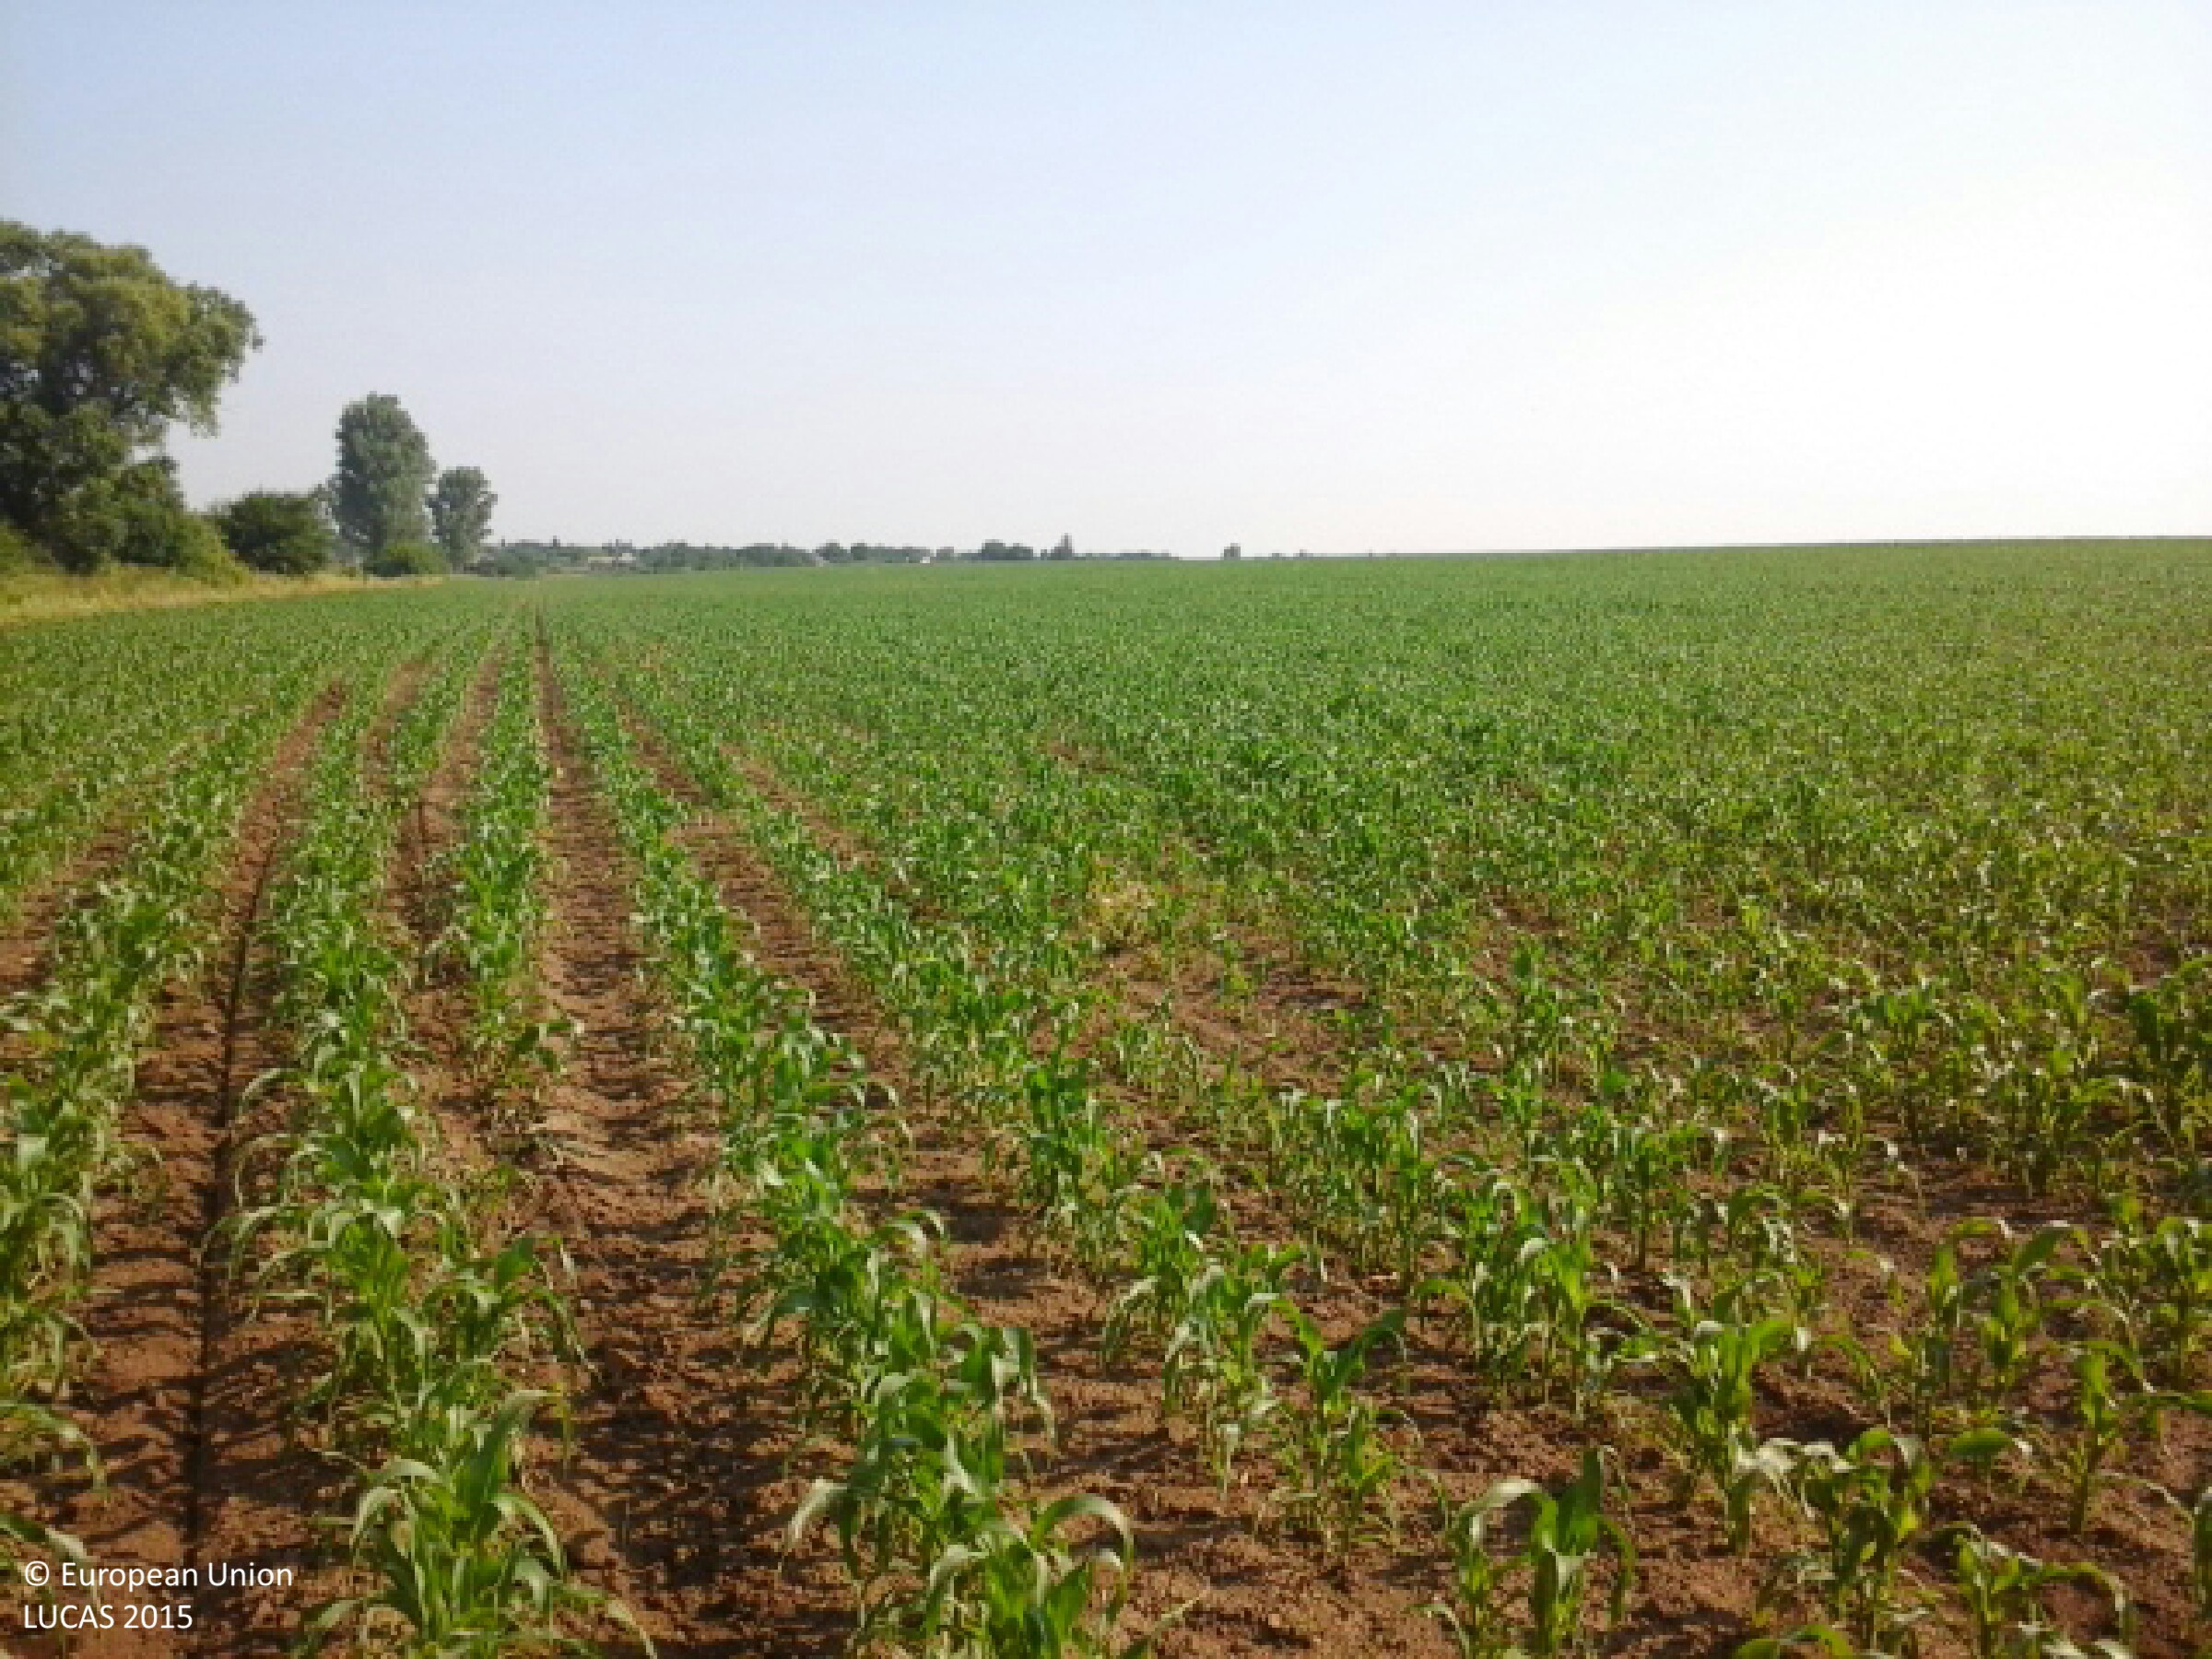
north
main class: Cropland
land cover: Maize
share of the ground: 25 - 50 %
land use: Agriculture (excluding fallow land and kitchen gardens)
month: July
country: HU
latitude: 48.1743
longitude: 21.0540
